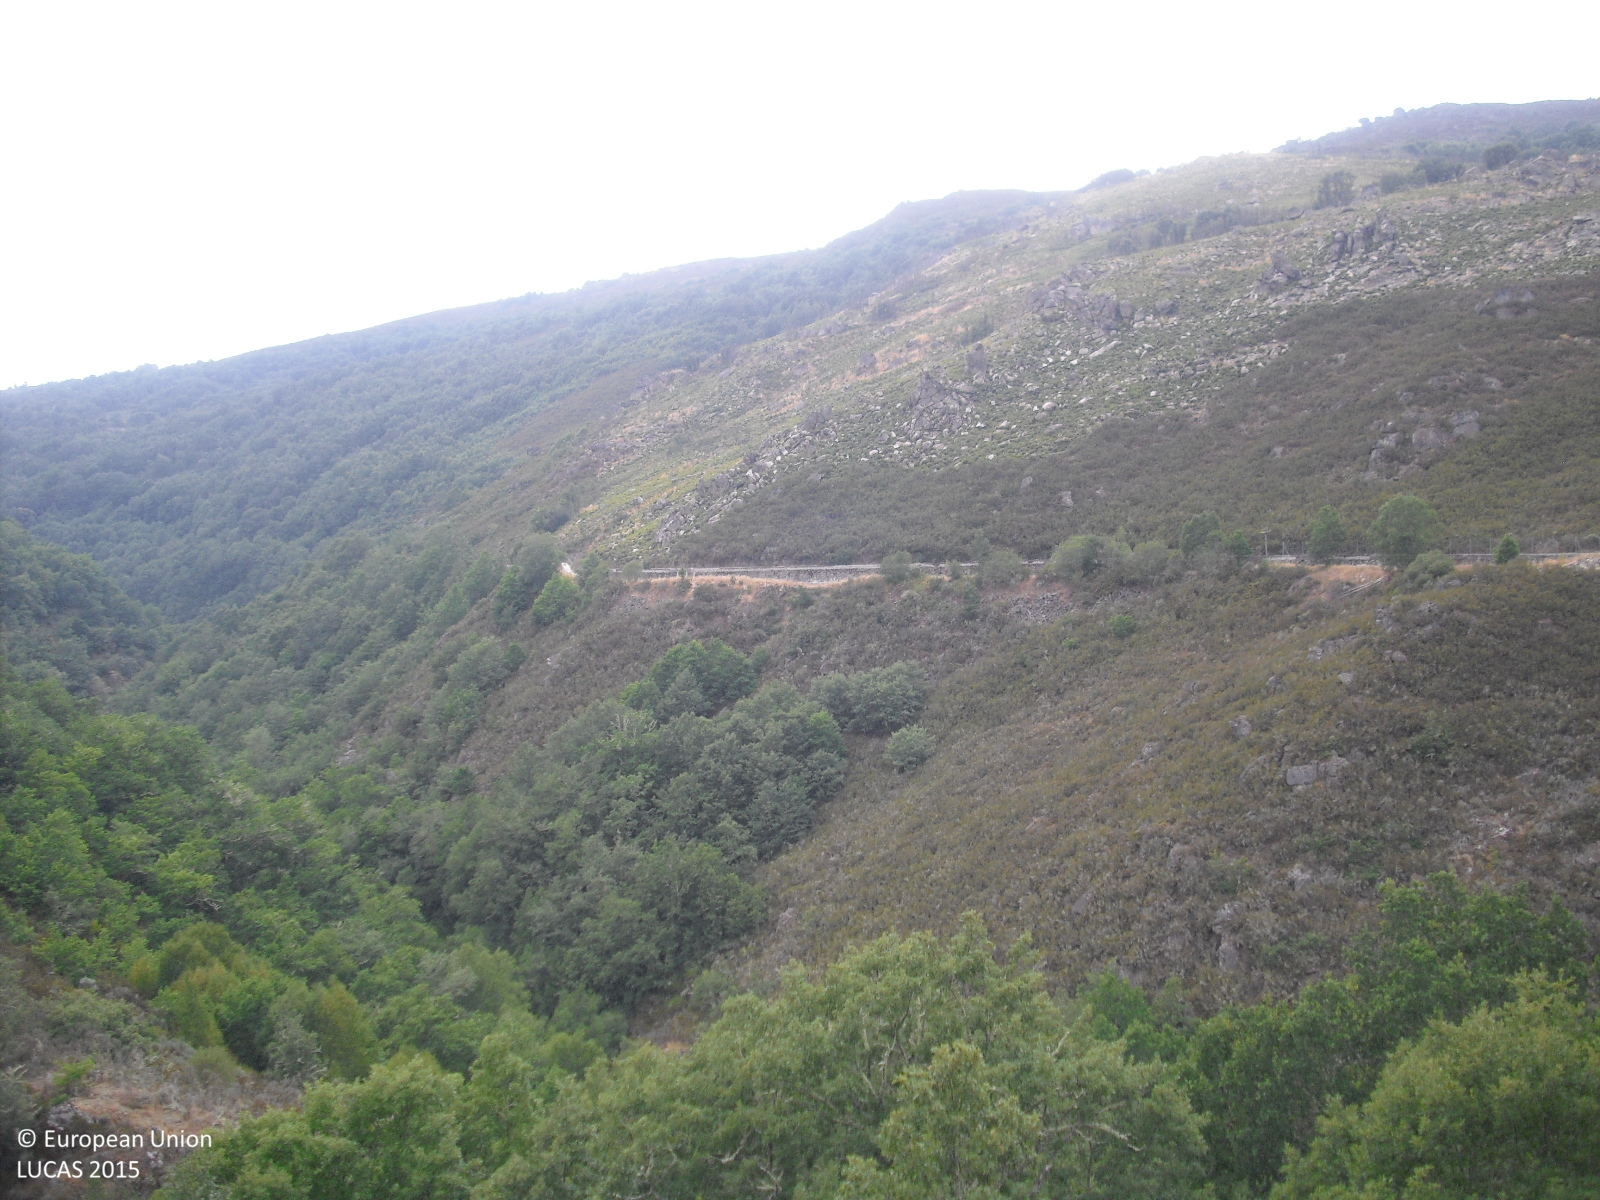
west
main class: Shrubland
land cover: Shrubland without tree cover
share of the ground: > 75 %
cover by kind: shrubs 100 %
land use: Semi-natural and natural areas not in use
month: July
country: ES
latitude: 42.2827
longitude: -7.3674
